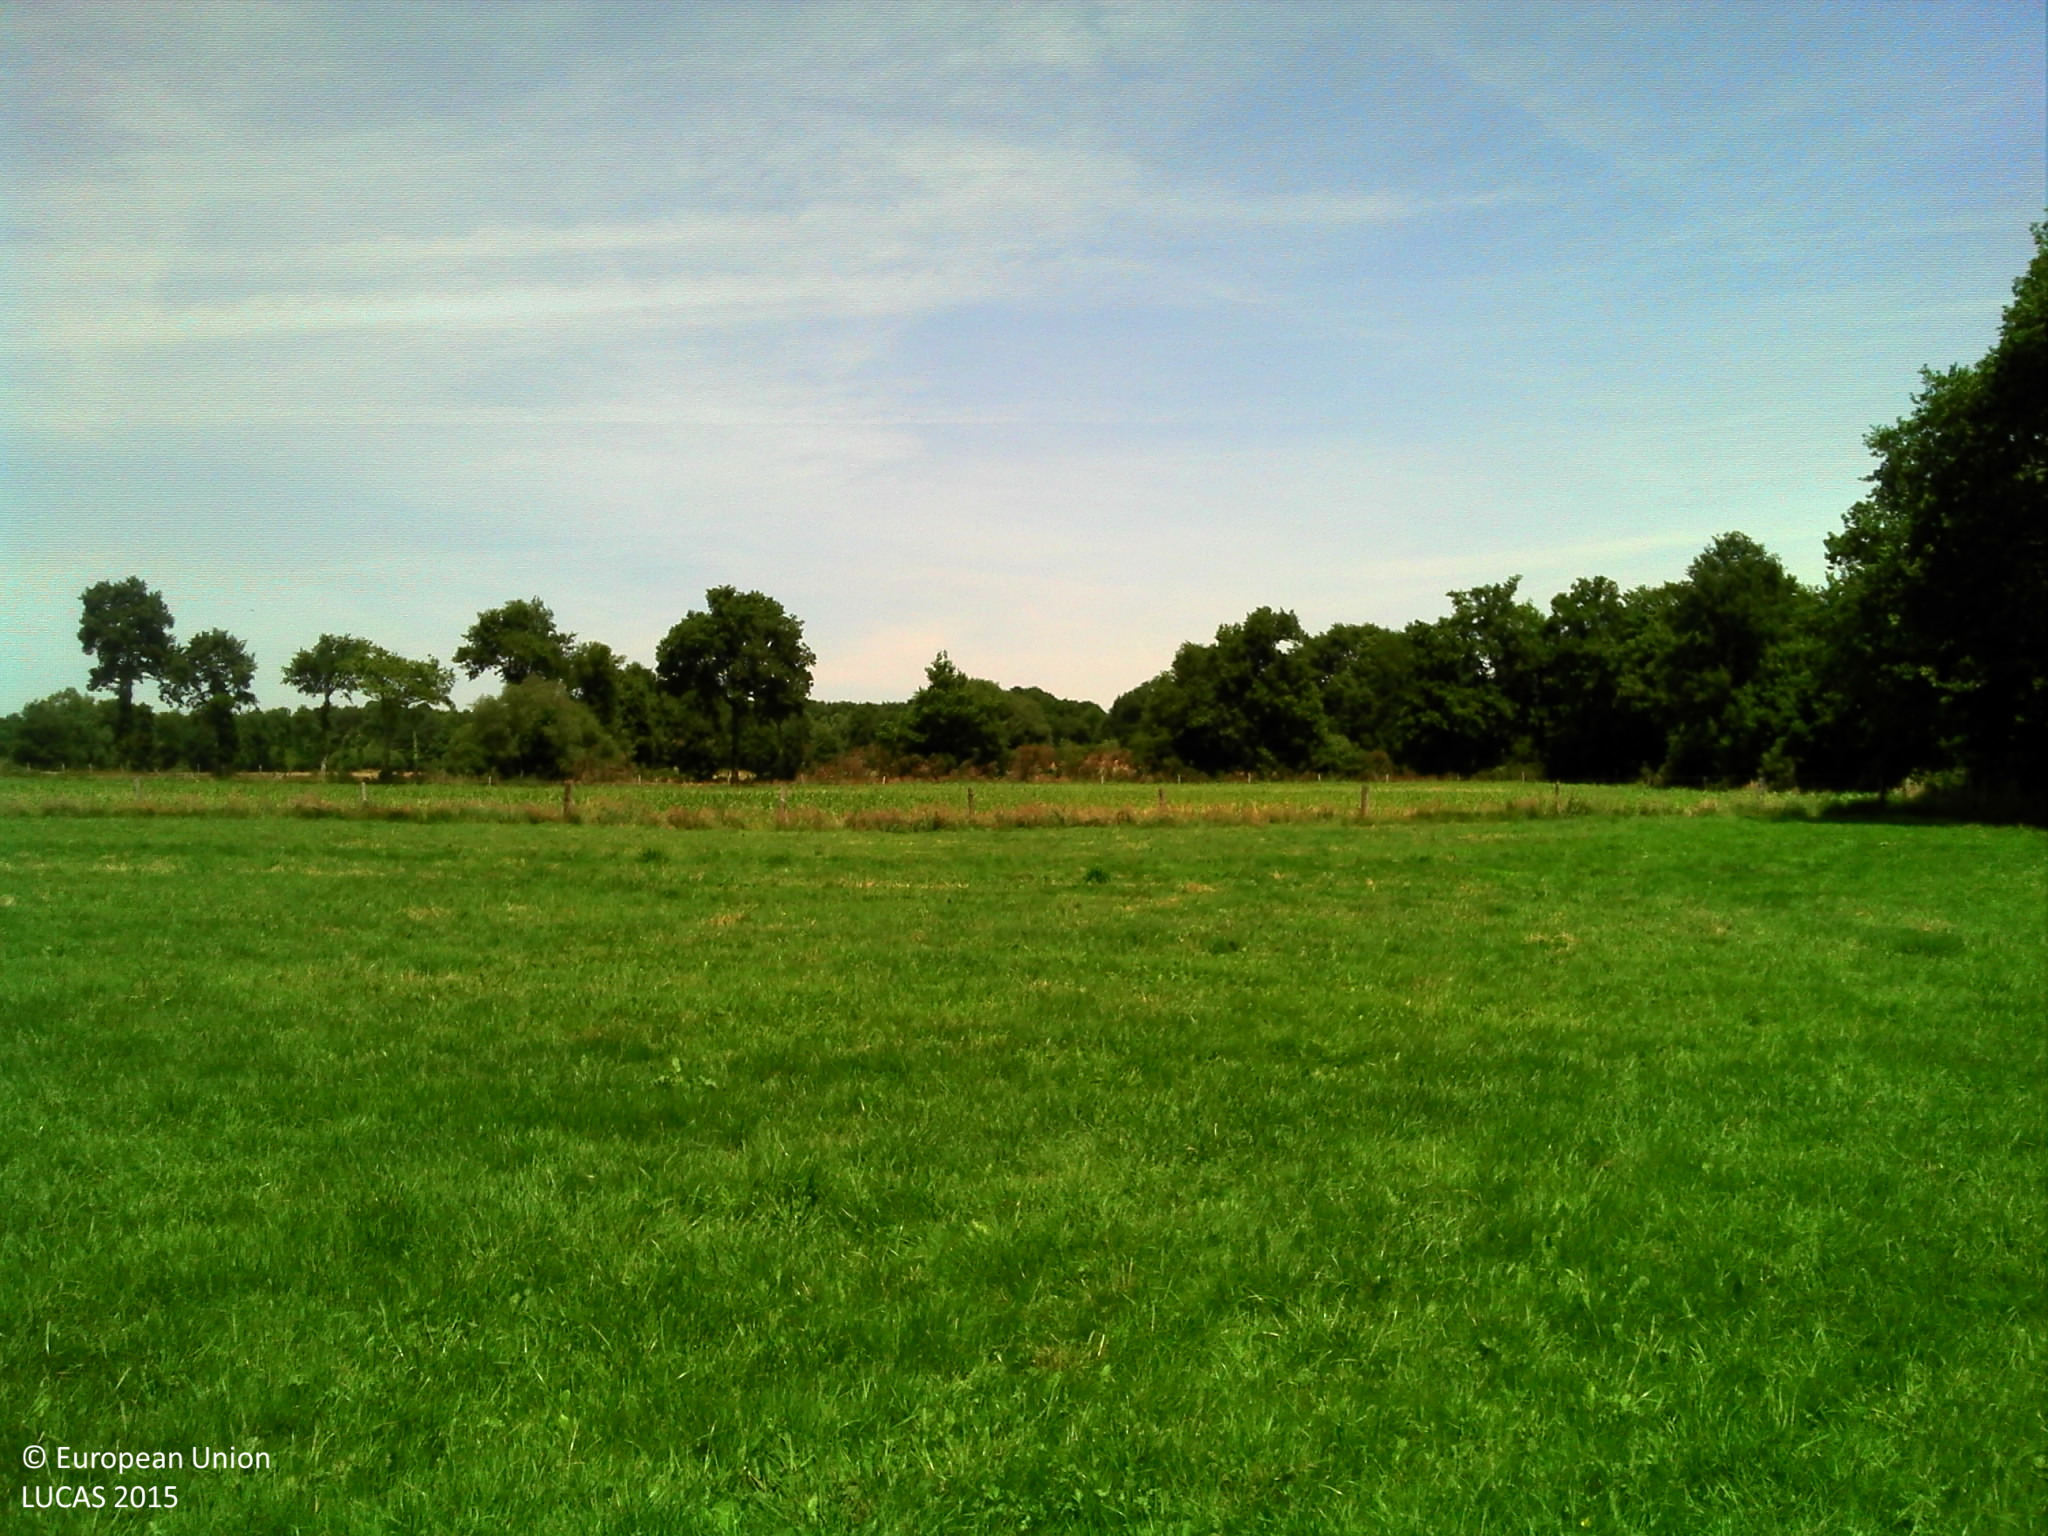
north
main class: Grassland
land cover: Grassland without tree/shrub cover
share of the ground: > 75 %
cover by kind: herbaceous plants 100 %
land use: Agriculture (excluding fallow land and kitchen gardens)
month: June
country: FR
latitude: 48.3208
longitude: -1.7423
